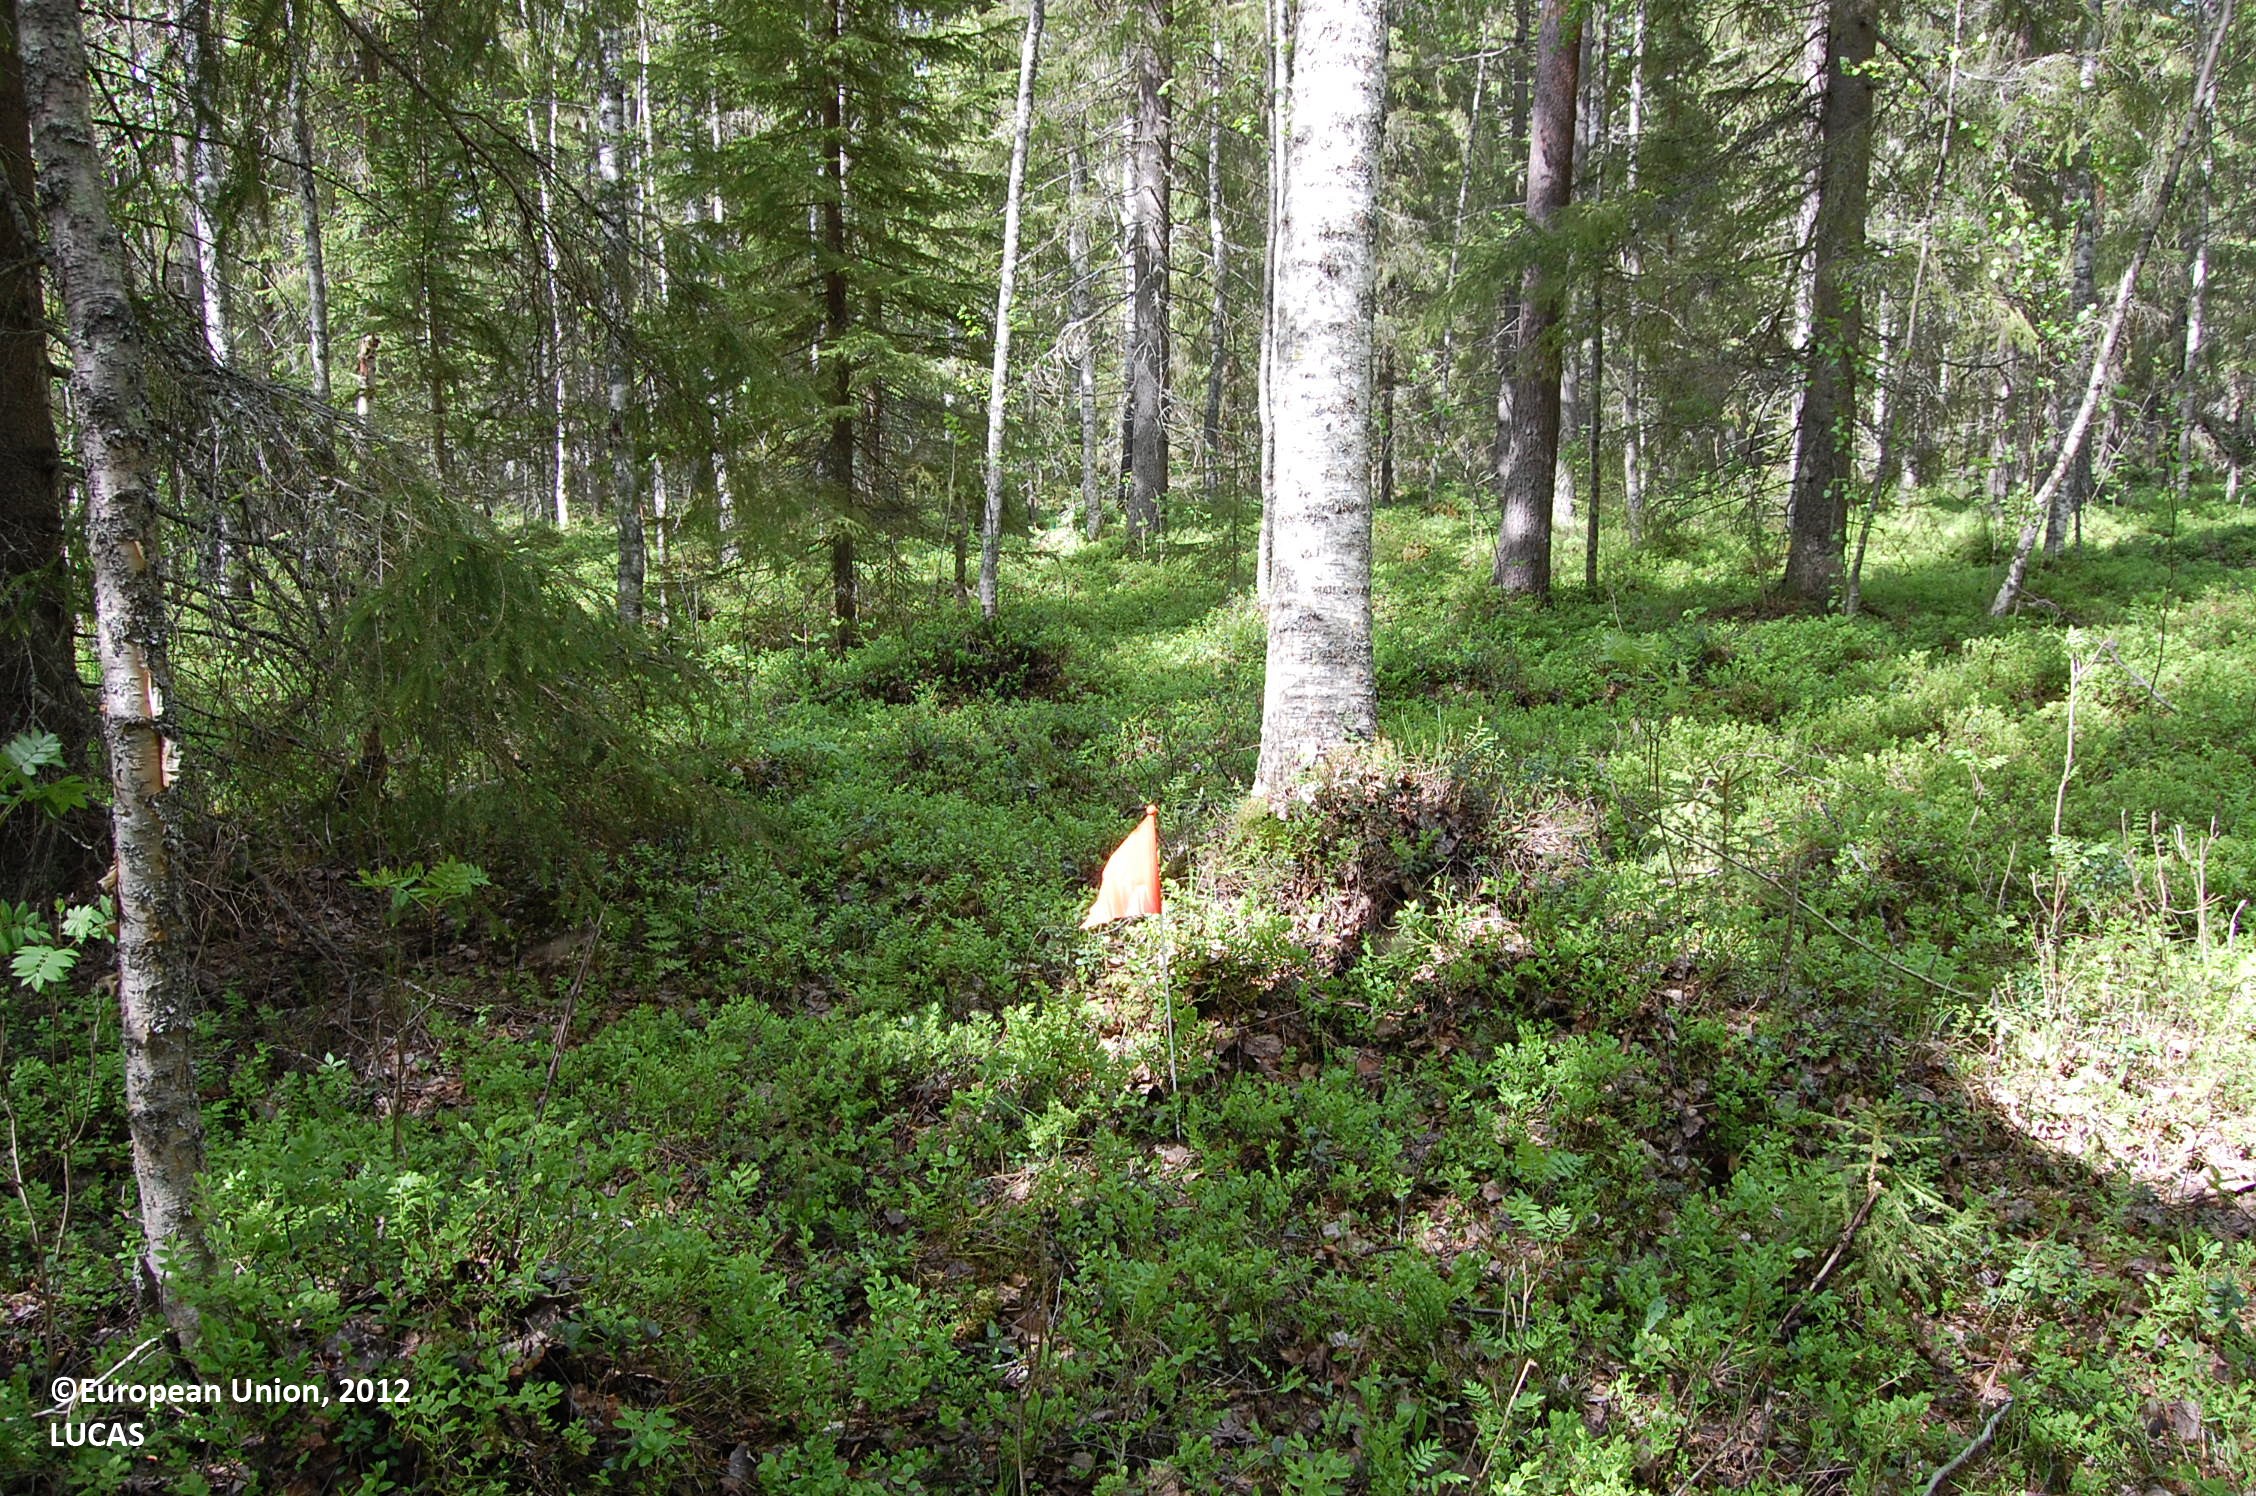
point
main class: Woodland
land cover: Spruce dominated mixed woodland
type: hemiboreal forest and nemoral coniferous forest and mixed broadleaved-coniferous forest
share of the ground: 50 - 75 %
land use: Forestry
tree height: > 5 m
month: June
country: FI
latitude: 64.0579
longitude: 26.1953
